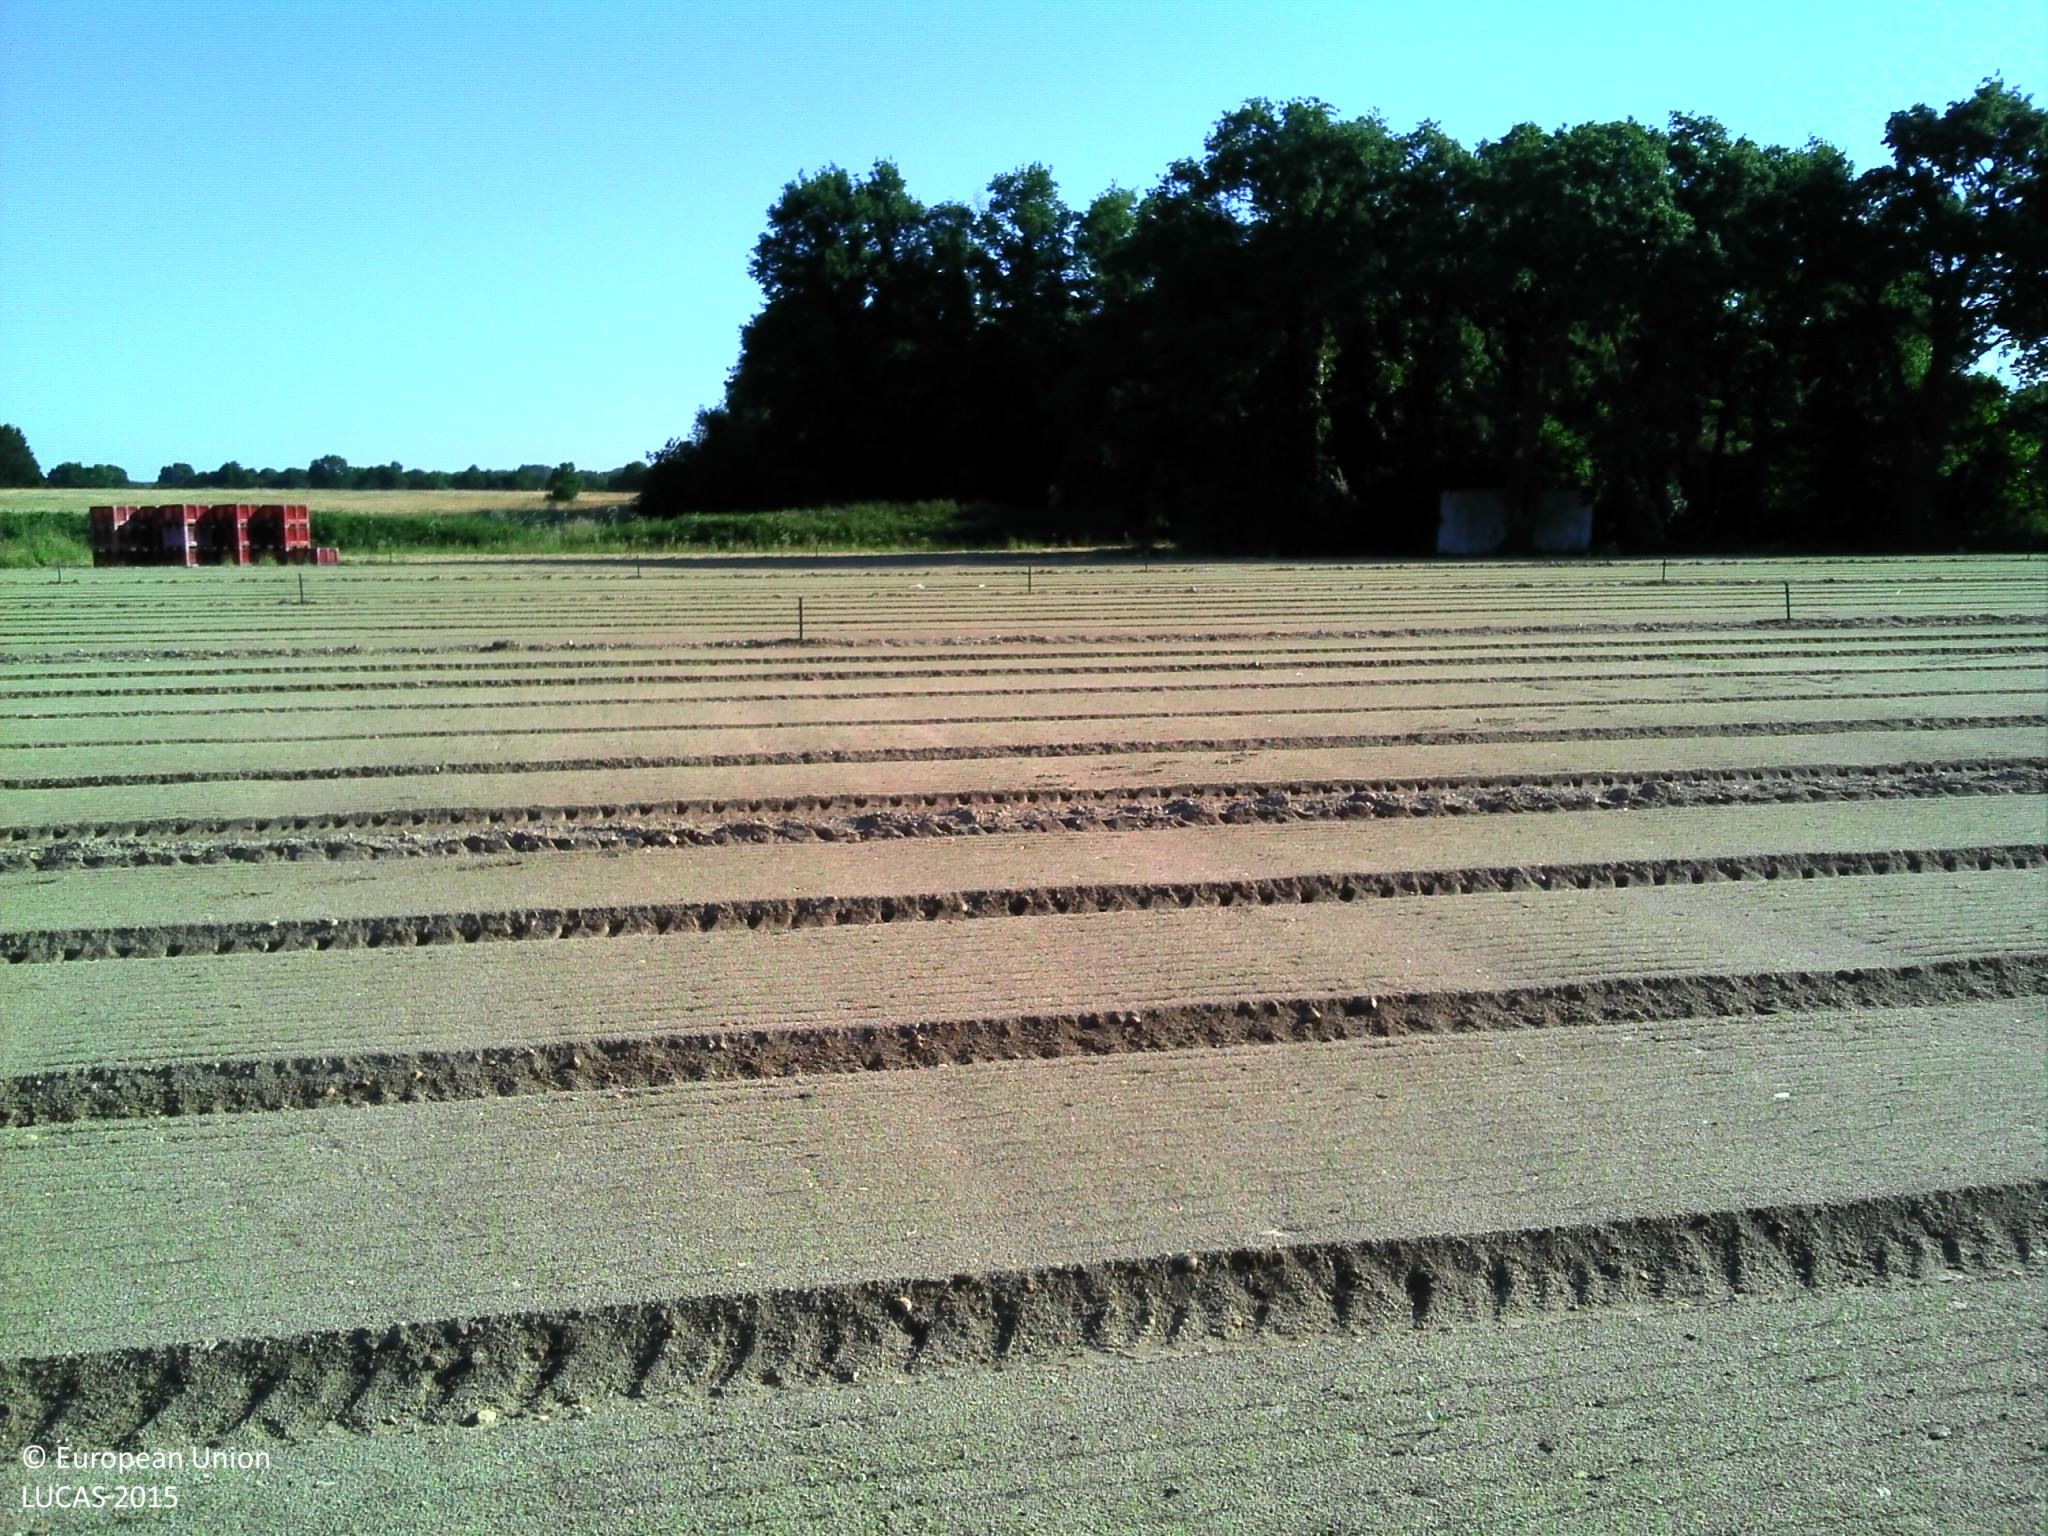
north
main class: Cropland
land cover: Other fresh vegetables
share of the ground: < 10 %
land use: Agriculture (excluding fallow land and kitchen gardens)
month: June
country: FR
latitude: 47.2972
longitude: -1.4540
